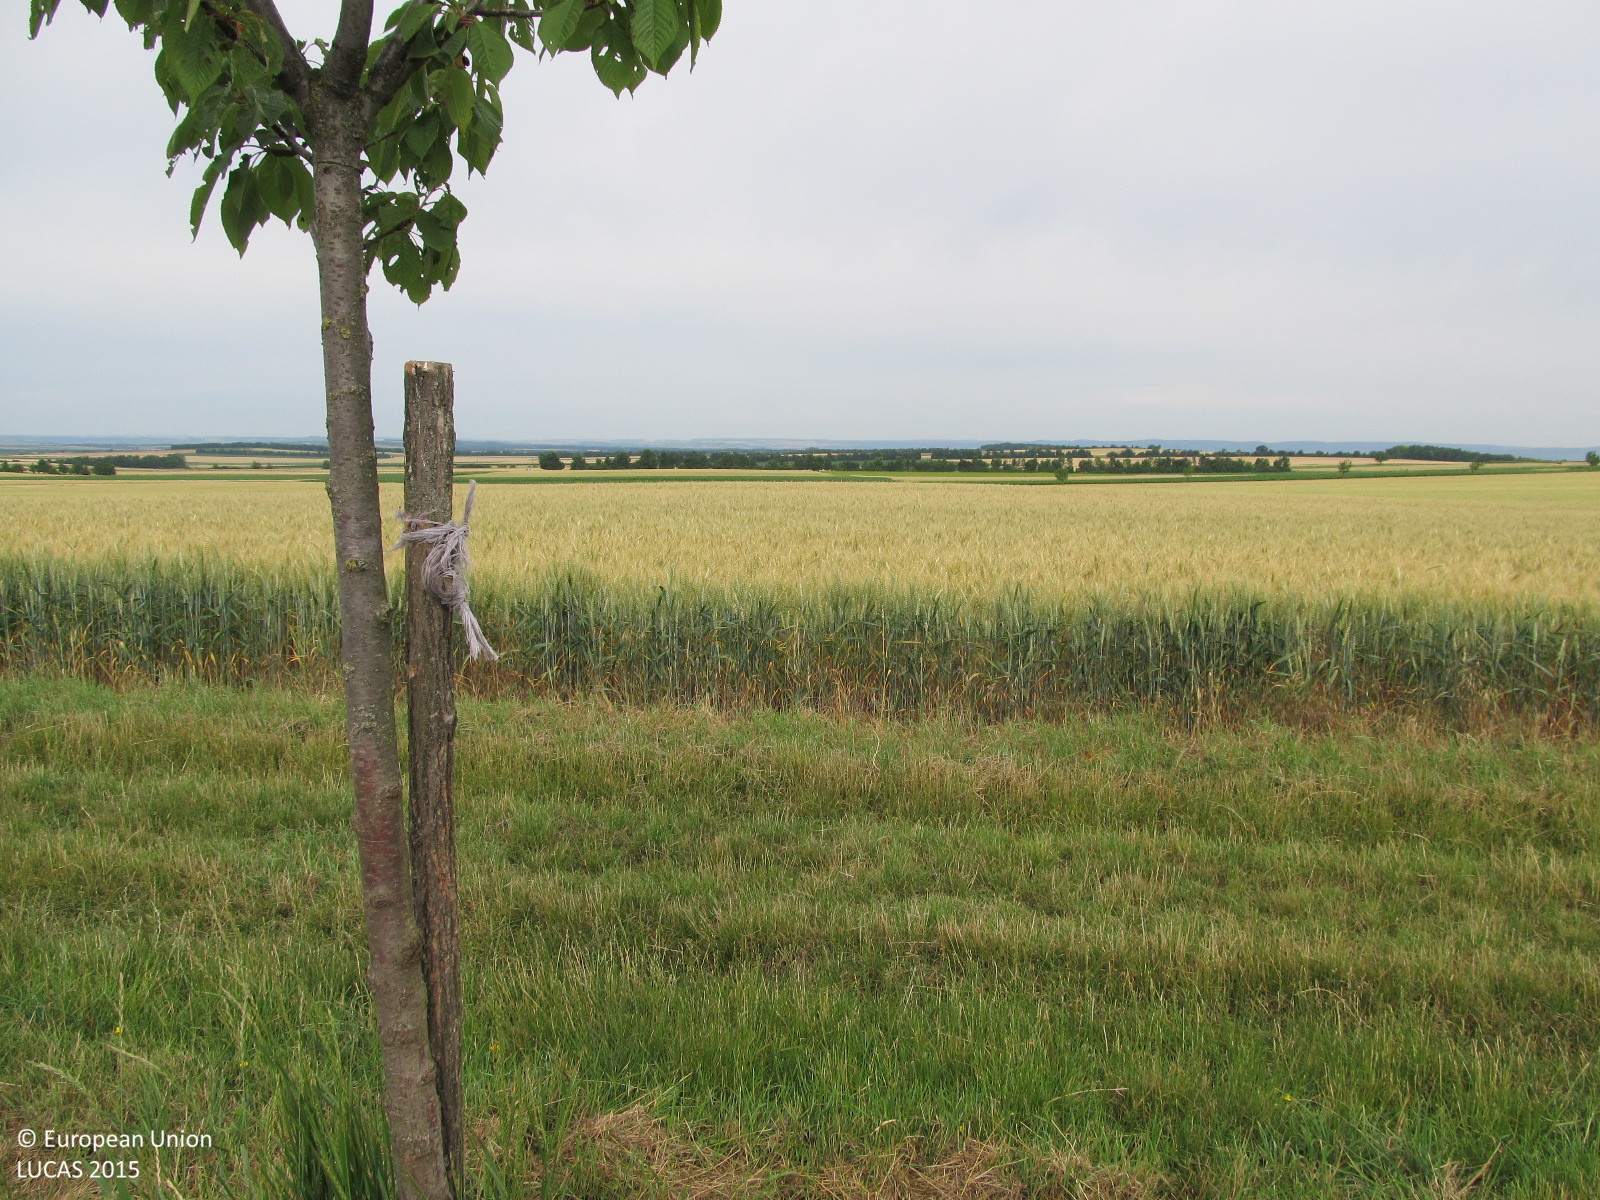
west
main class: Cropland
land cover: Common wheat
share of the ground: > 75 %
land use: Agriculture (excluding fallow land and kitchen gardens)
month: June
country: AT
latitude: 48.6680
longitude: 16.1016
